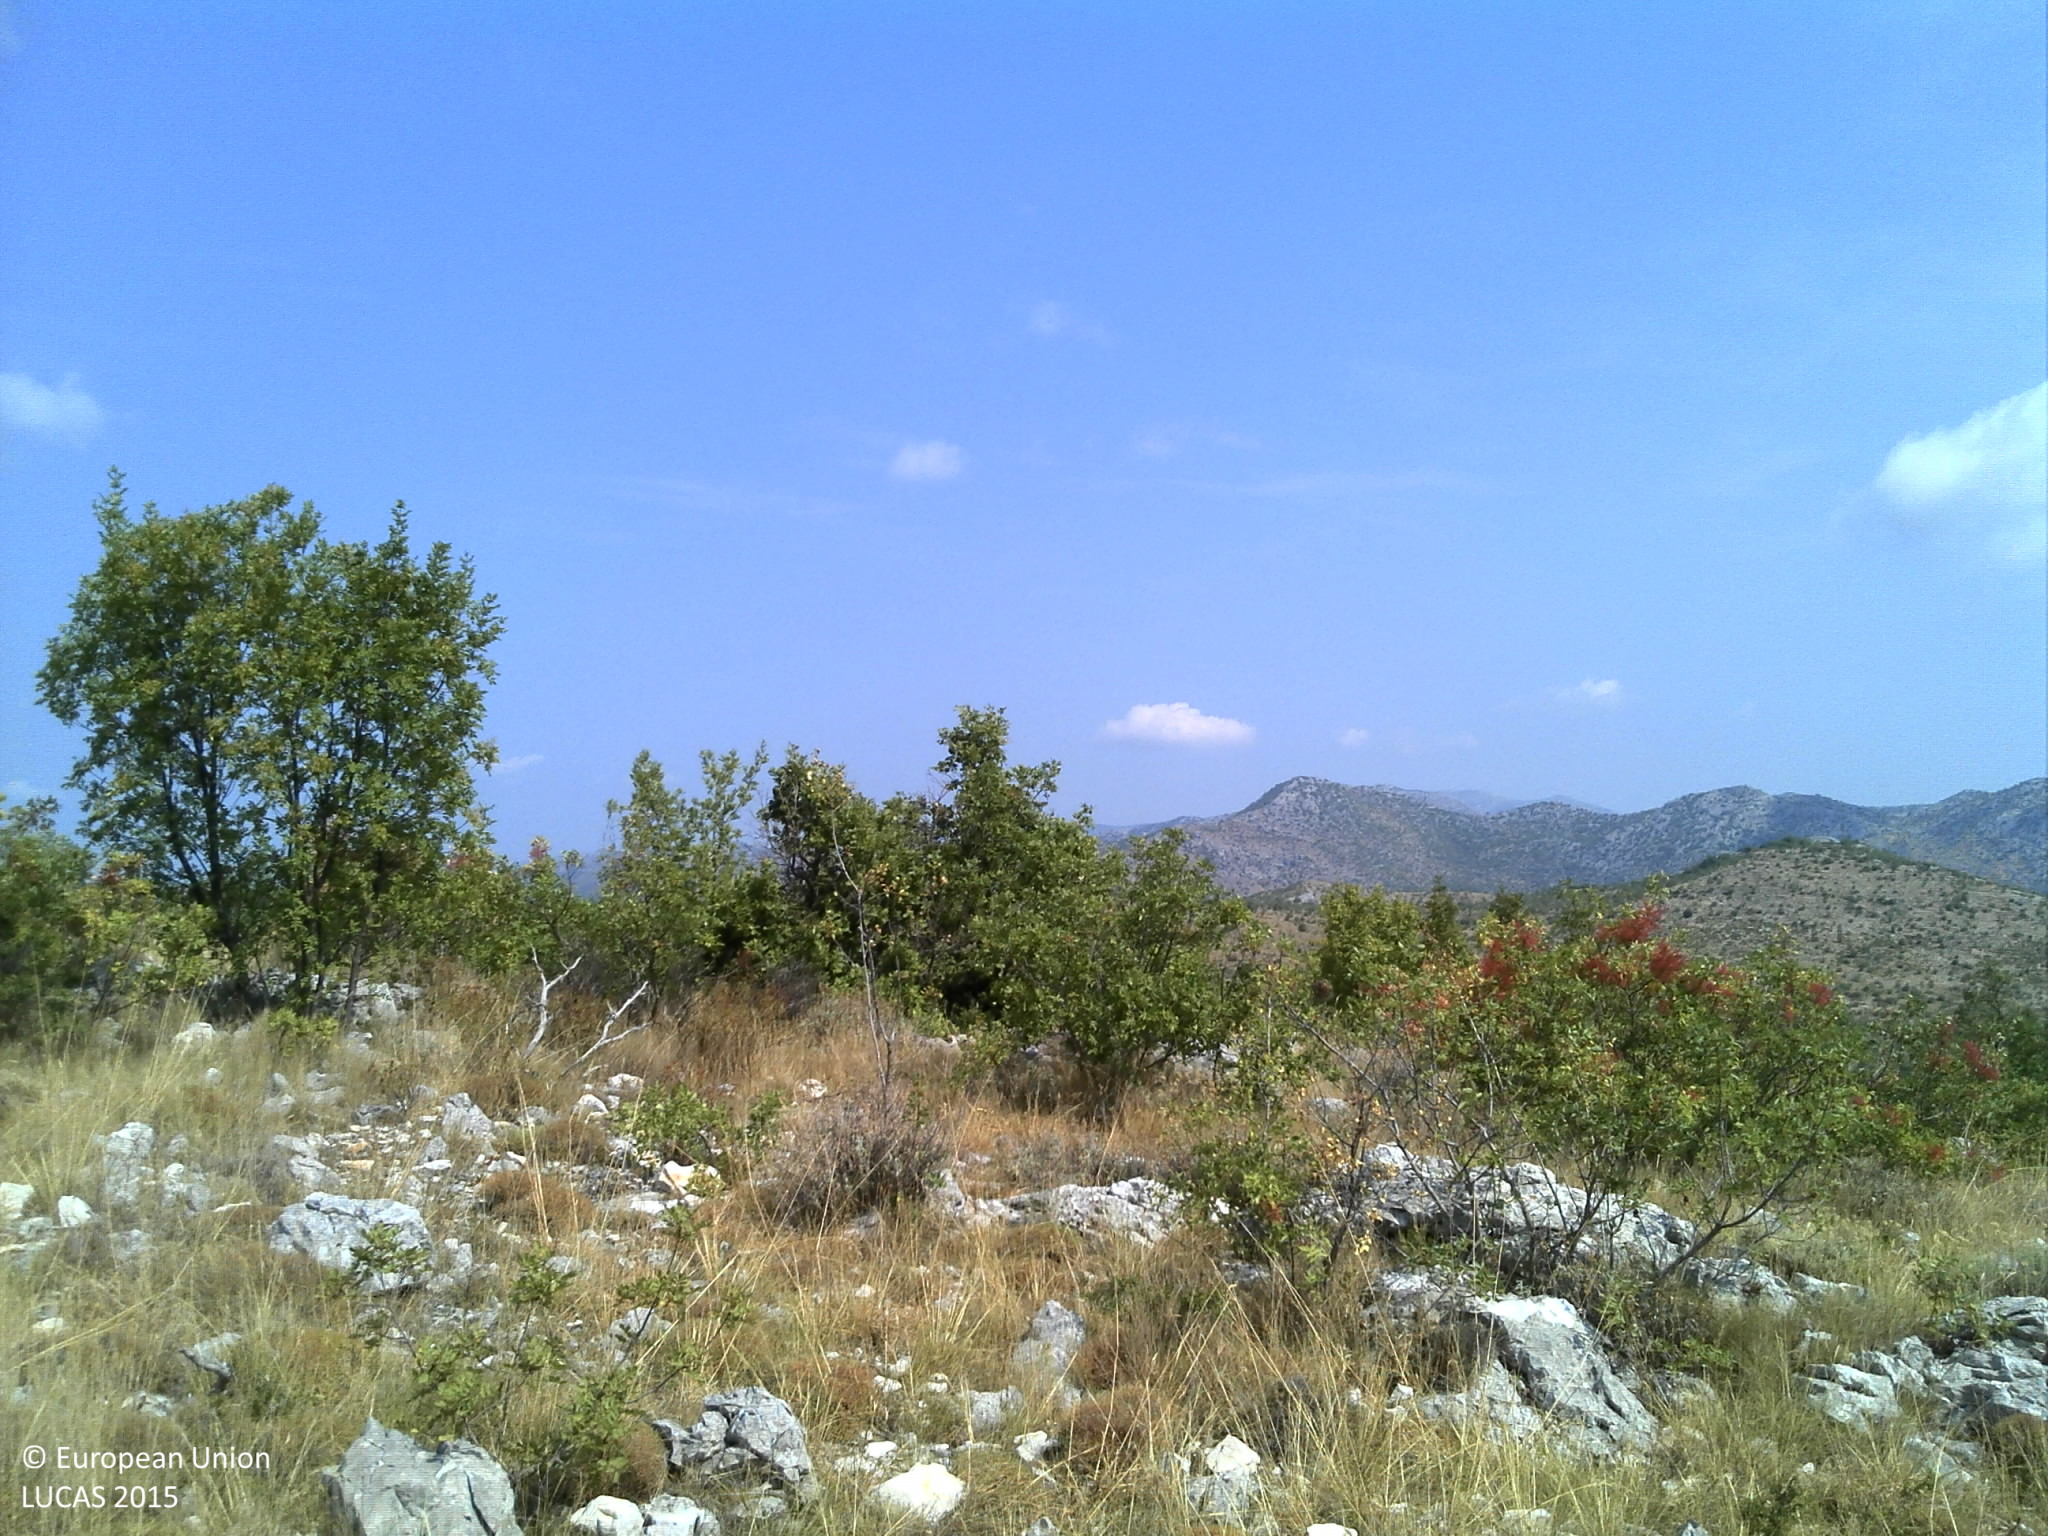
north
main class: Shrubland
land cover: Shrubland with sparse tree cover
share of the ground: 25 - 50 %
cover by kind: shrubs 40 %, herbaceous plants 35 %, consolidated bare surface 15 %, coniferous forest trees 5 %, unconsolidated bare surface 5 %
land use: Semi-natural and natural areas not in use
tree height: < 5 m
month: July
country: HR
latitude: 42.8456
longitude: 17.7603
